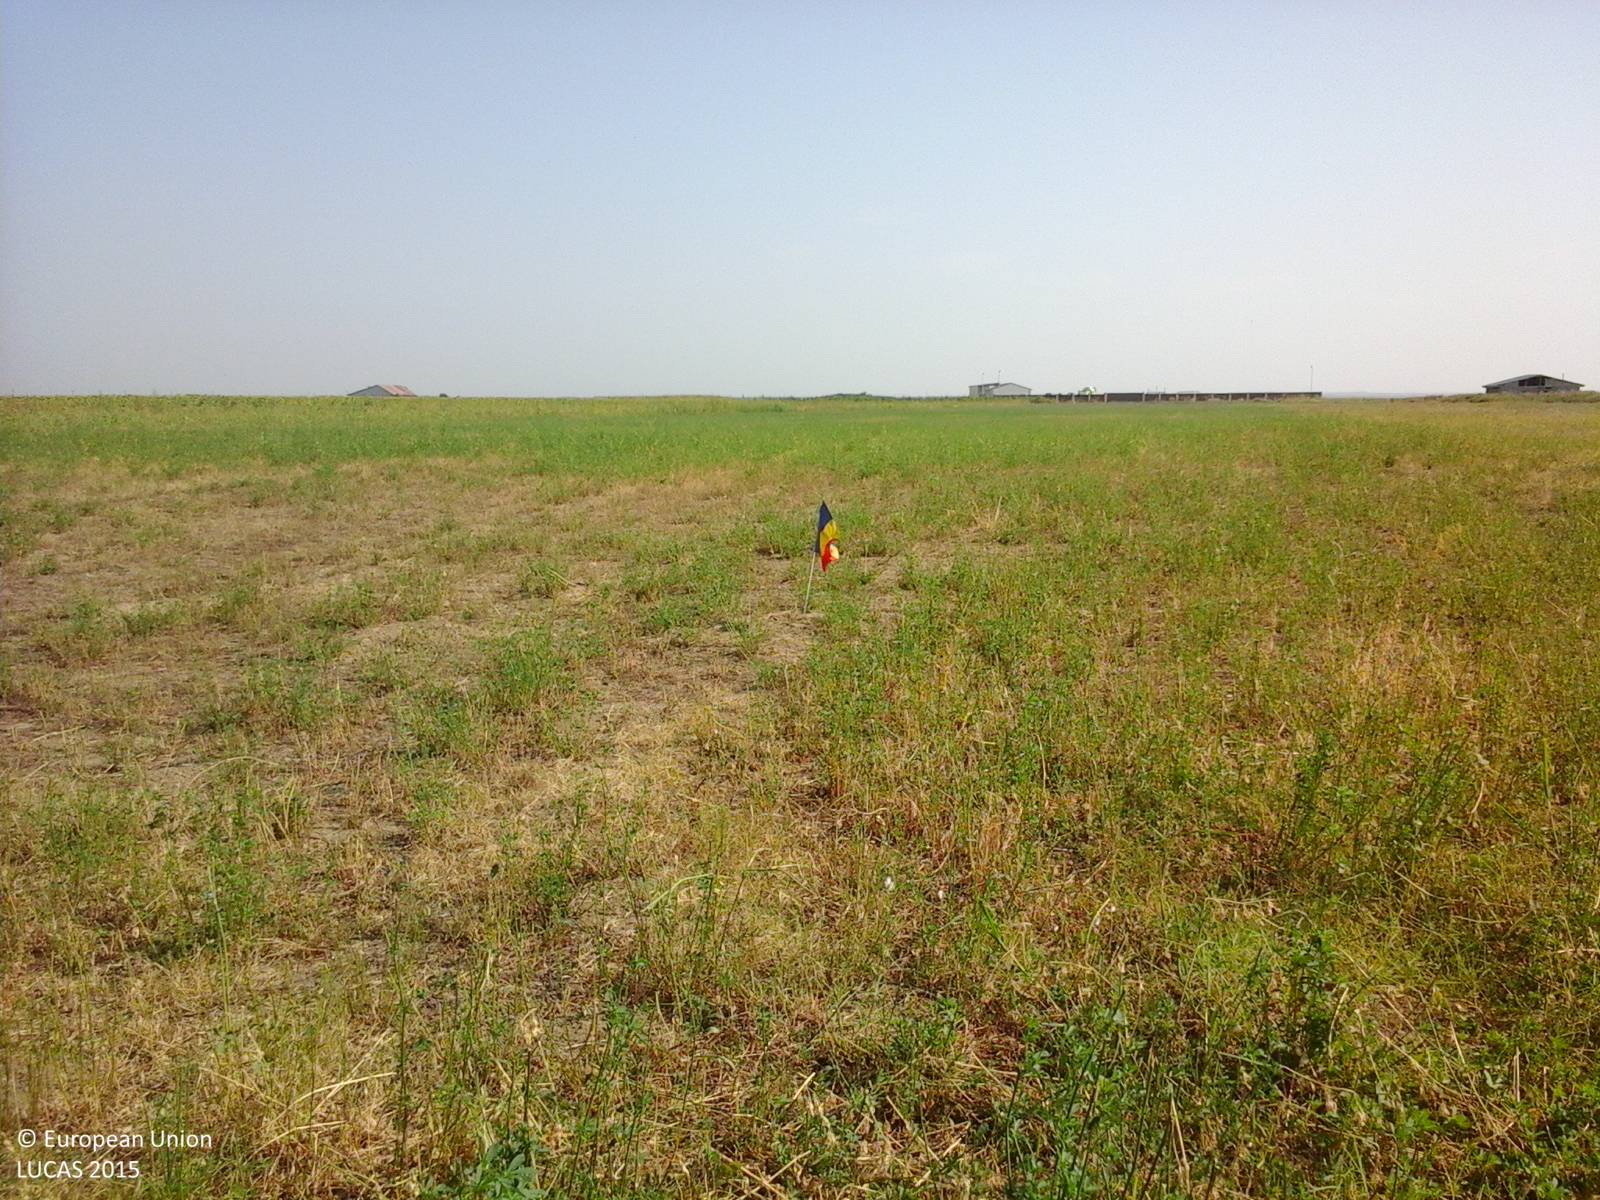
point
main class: Cropland
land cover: Lucerne
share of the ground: 25 - 50 %
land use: Agriculture (excluding fallow land and kitchen gardens)
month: August
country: RO
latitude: 45.3384
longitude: 27.8100
